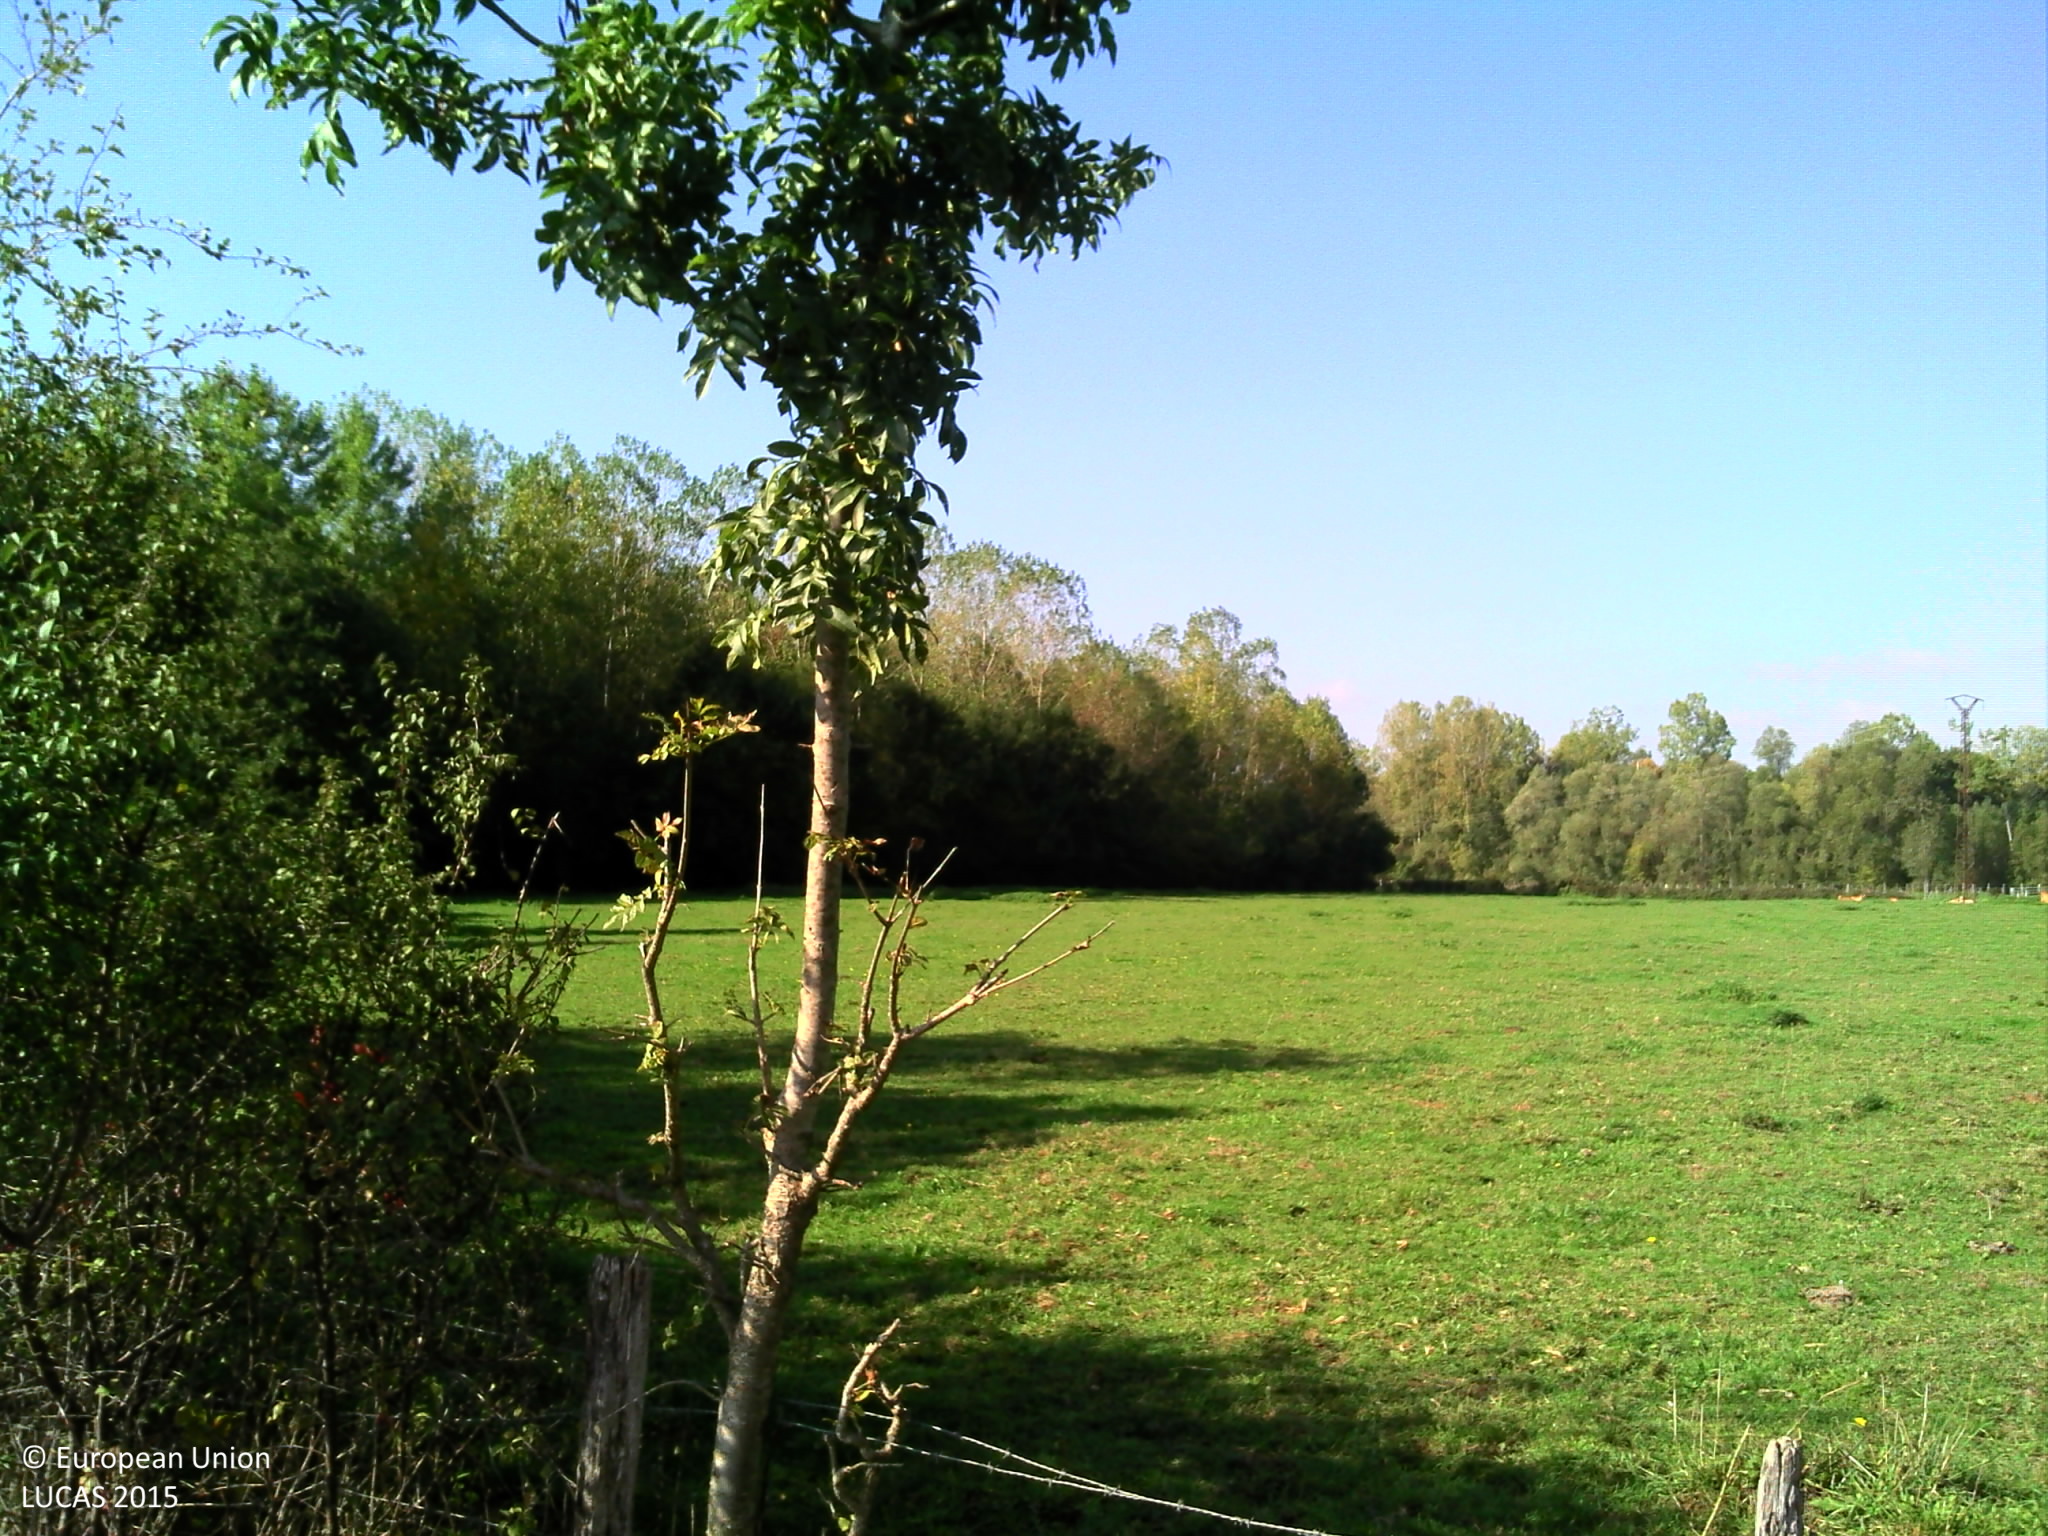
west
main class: Grassland
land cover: Grassland without tree/shrub cover
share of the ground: > 75 %
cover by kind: herbaceous plants 100 %
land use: Agriculture (excluding fallow land and kitchen gardens)
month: October
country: FR
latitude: 46.3185
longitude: 4.8724
